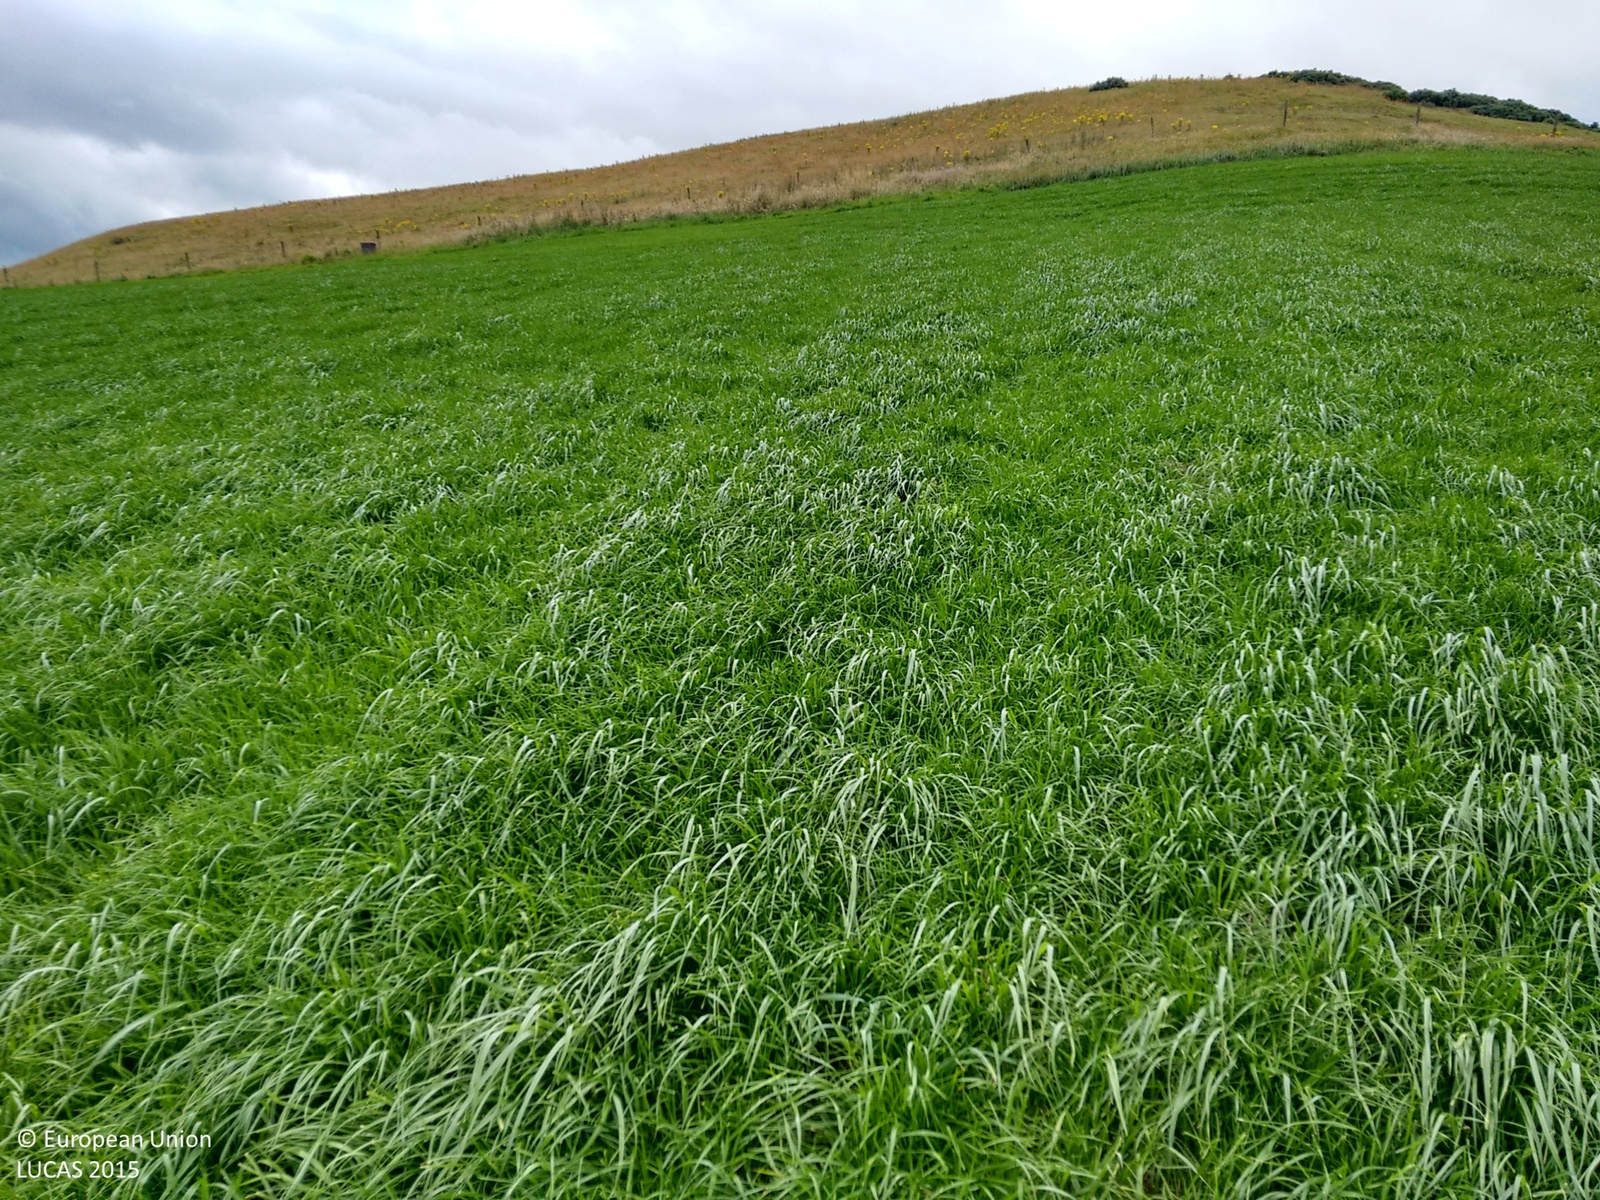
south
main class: Cropland
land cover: Temporary grasslands
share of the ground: > 75 %
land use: Agriculture (excluding fallow land and kitchen gardens)
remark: Harvested field
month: August
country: GB
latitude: 55.4965
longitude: -2.3581
